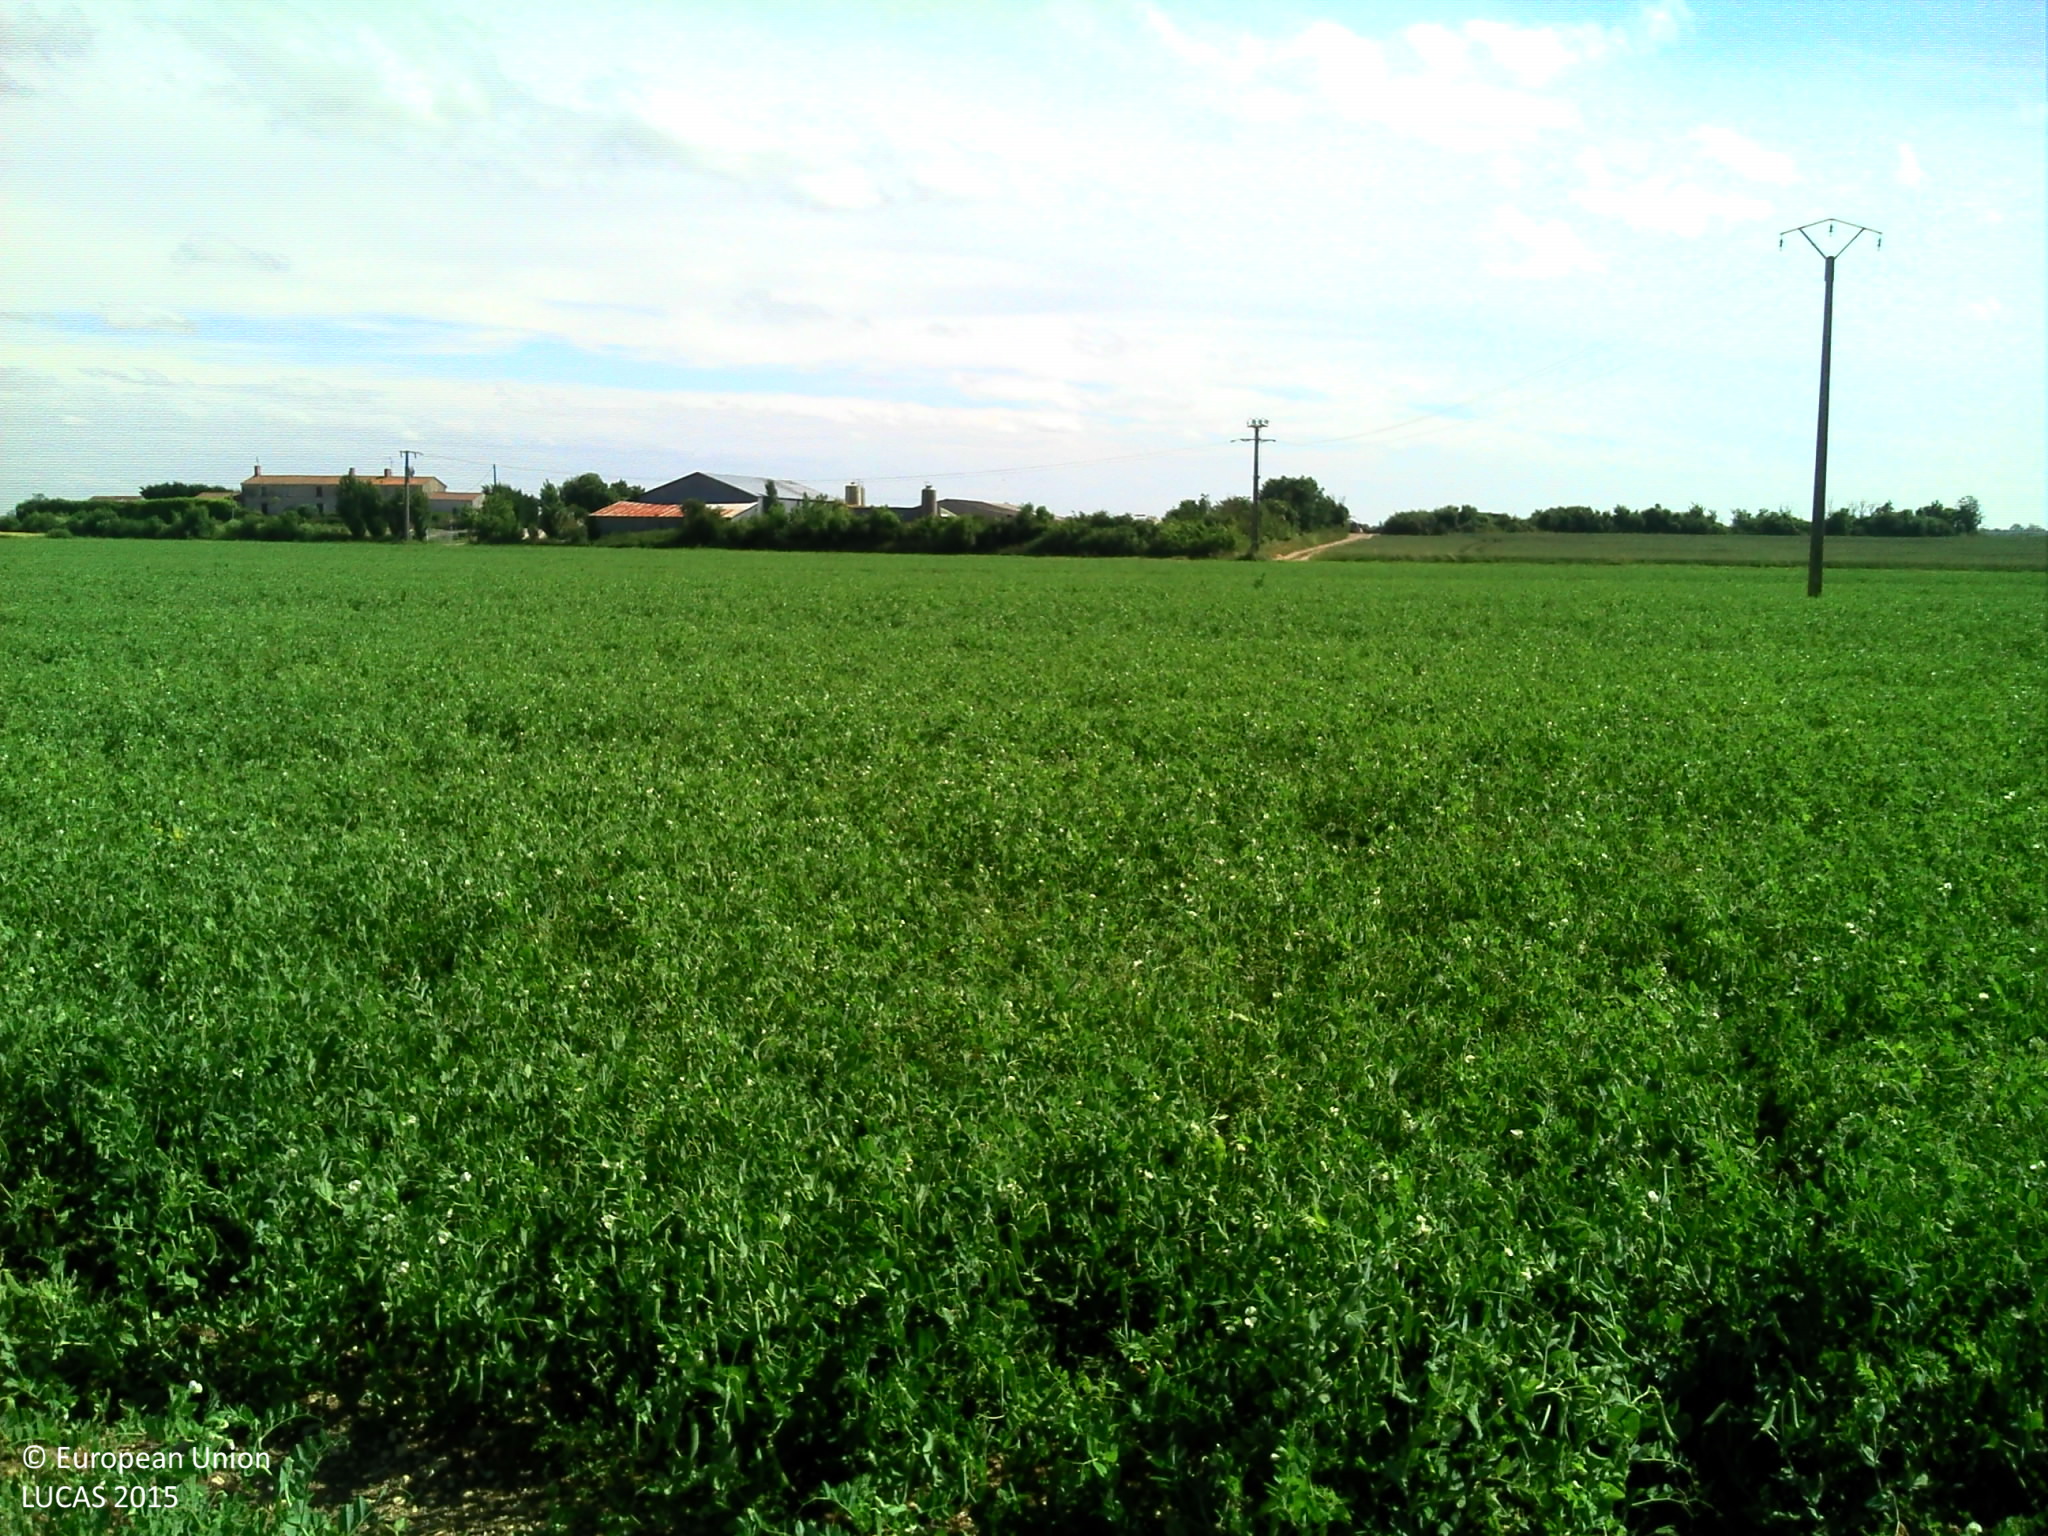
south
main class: Cropland
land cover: Dry pulses
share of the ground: > 75 %
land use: Agriculture (excluding fallow land and kitchen gardens)
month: June
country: FR
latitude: 46.2936
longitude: -0.9737
